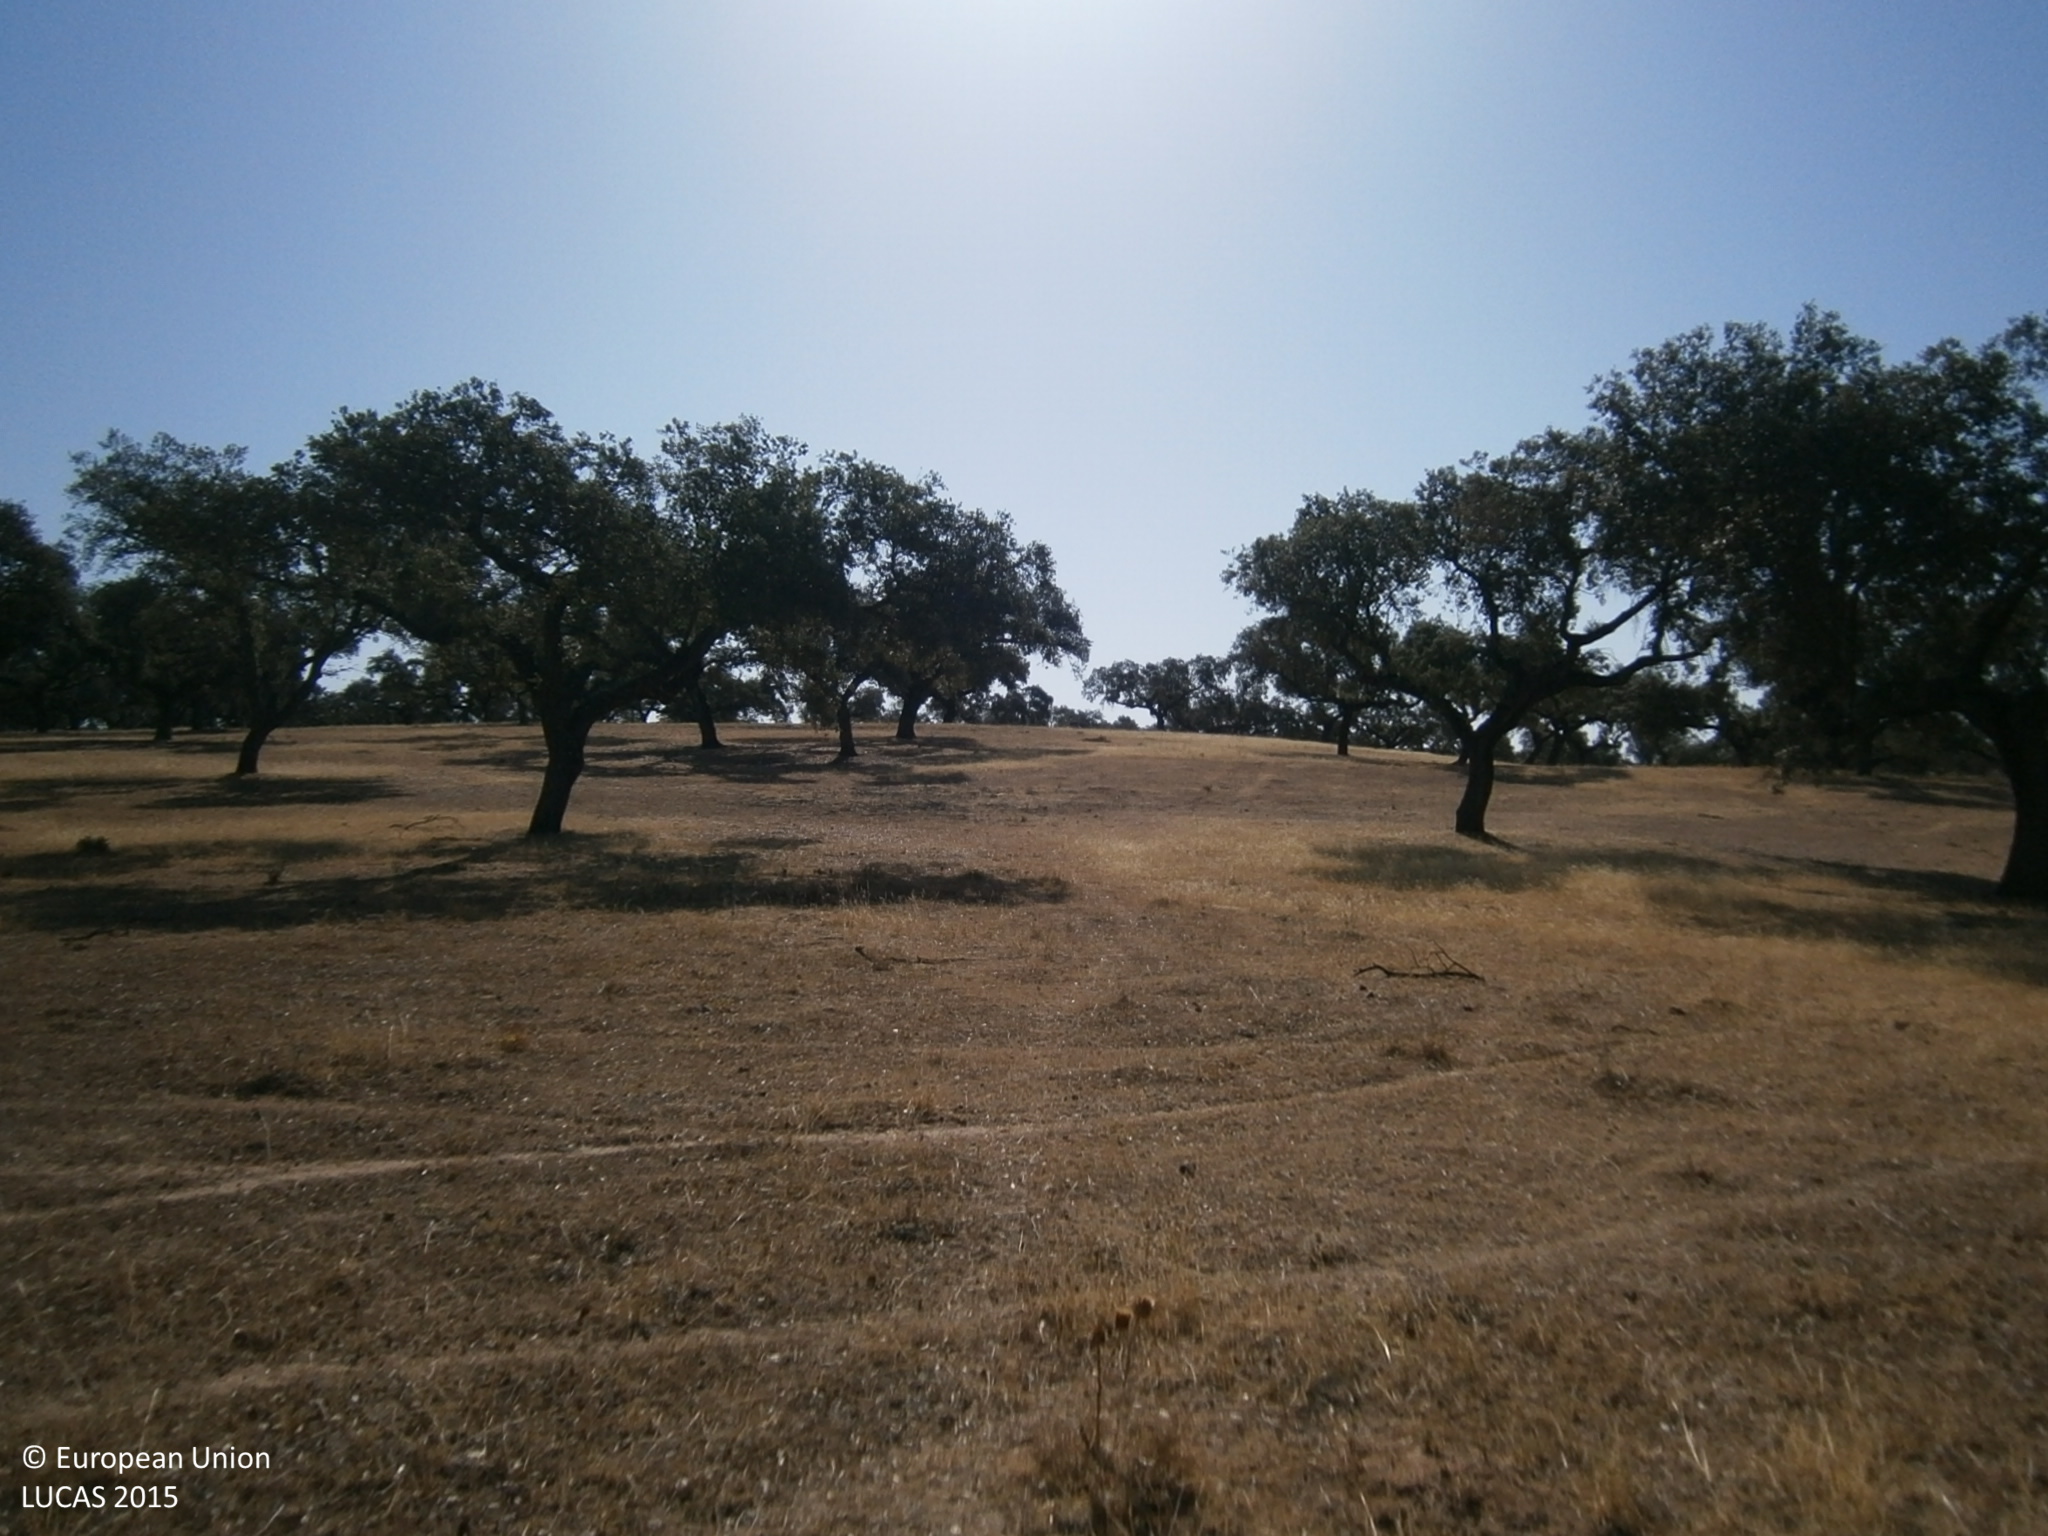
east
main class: Woodland
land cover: Broadleaved woodland
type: broadleaved evergreen forest
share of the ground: 10 - 25 %
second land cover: Spontaneously vegetated surfaces
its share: 50 - 75 %
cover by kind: herbaceous plants 65 %, broadleaved forest trees 25 %, unconsolidated bare surface 10 %
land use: Forestry
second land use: Agriculture (excluding fallow land and kitchen gardens)
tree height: > 5 m
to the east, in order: Broadleaved woodland; Spontaneously vegetated surfaces; Fences; Broadleaved woodland
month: July
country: ES
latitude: 39.0389
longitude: -6.7389
